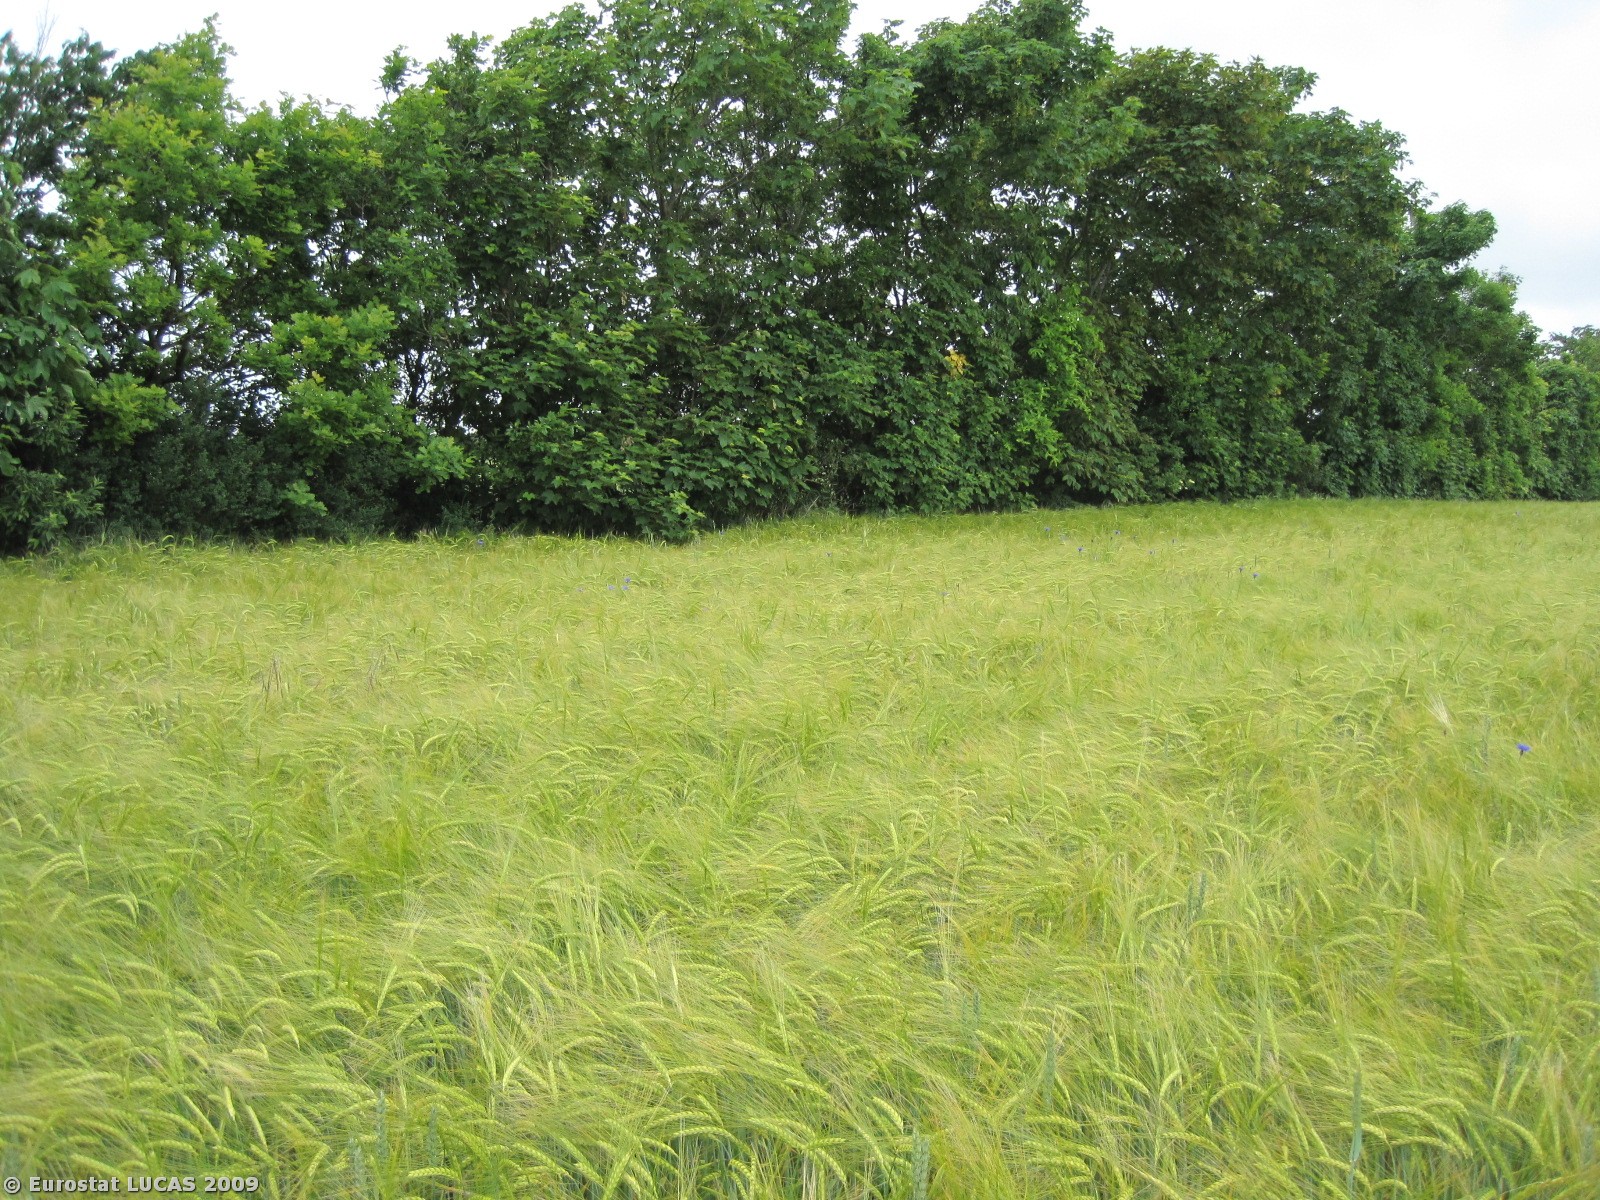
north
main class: Cropland
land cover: Barley
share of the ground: > 75 %
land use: Agriculture (excluding fallow land and kitchen gardens)
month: June
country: DK
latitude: 57.2124
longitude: 9.9835
